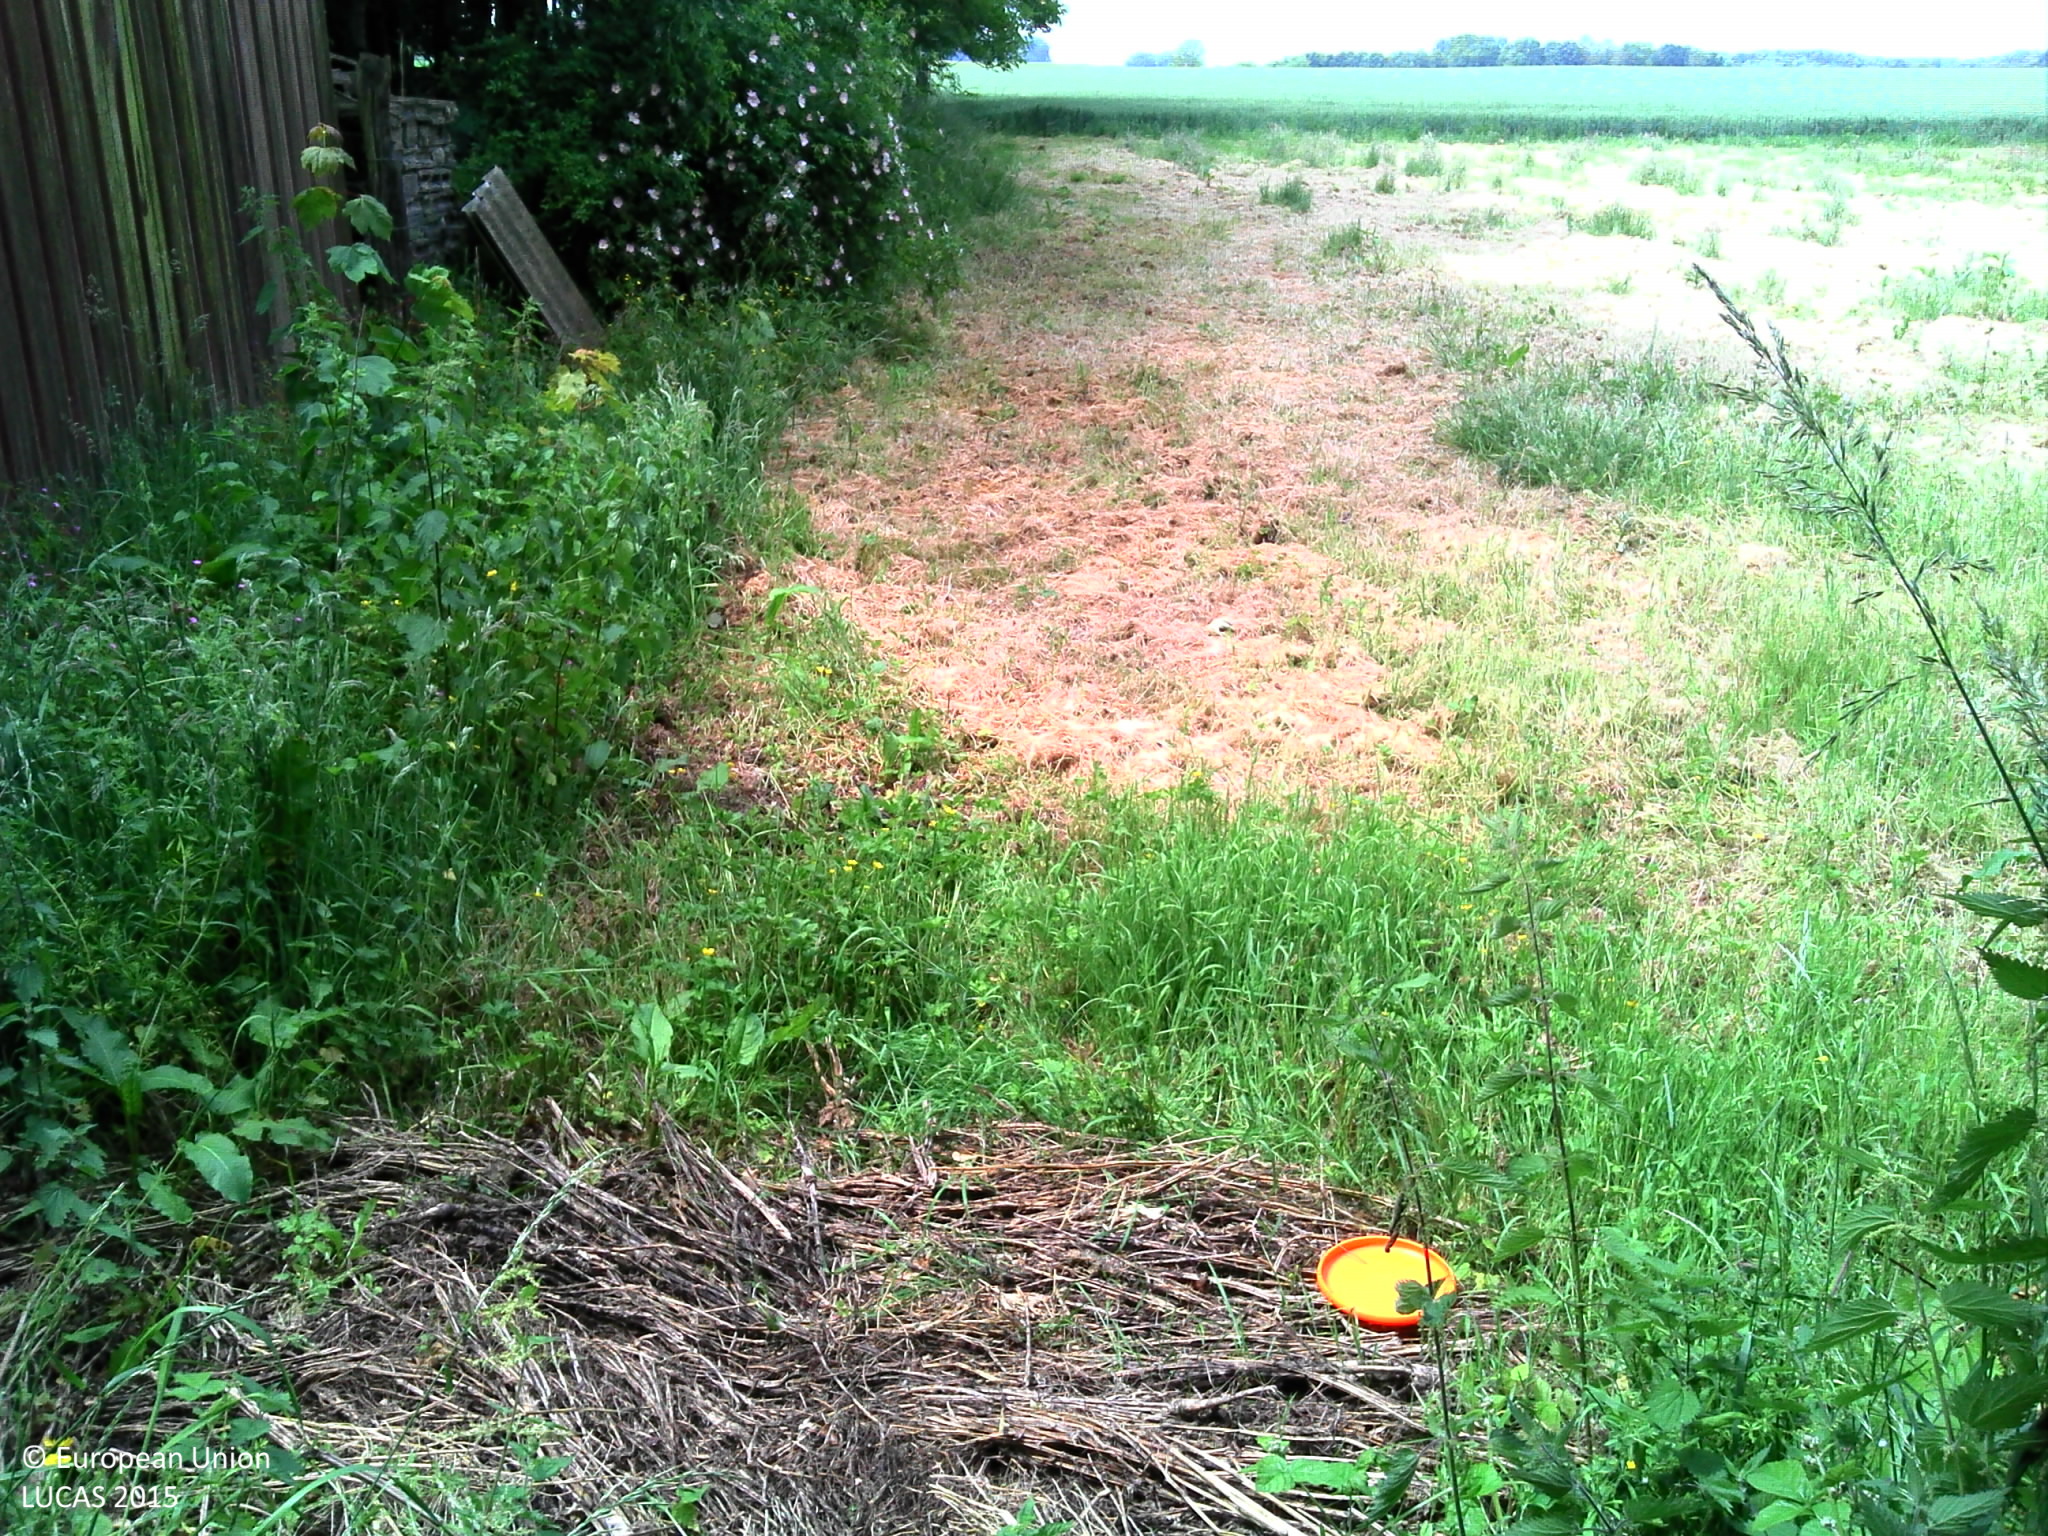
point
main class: Grassland
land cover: Grassland without tree/shrub cover
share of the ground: > 75 %
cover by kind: herbaceous plants 80 %
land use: Semi-natural and natural areas not in use
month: June
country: FR
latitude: 50.5112
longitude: 2.4426
